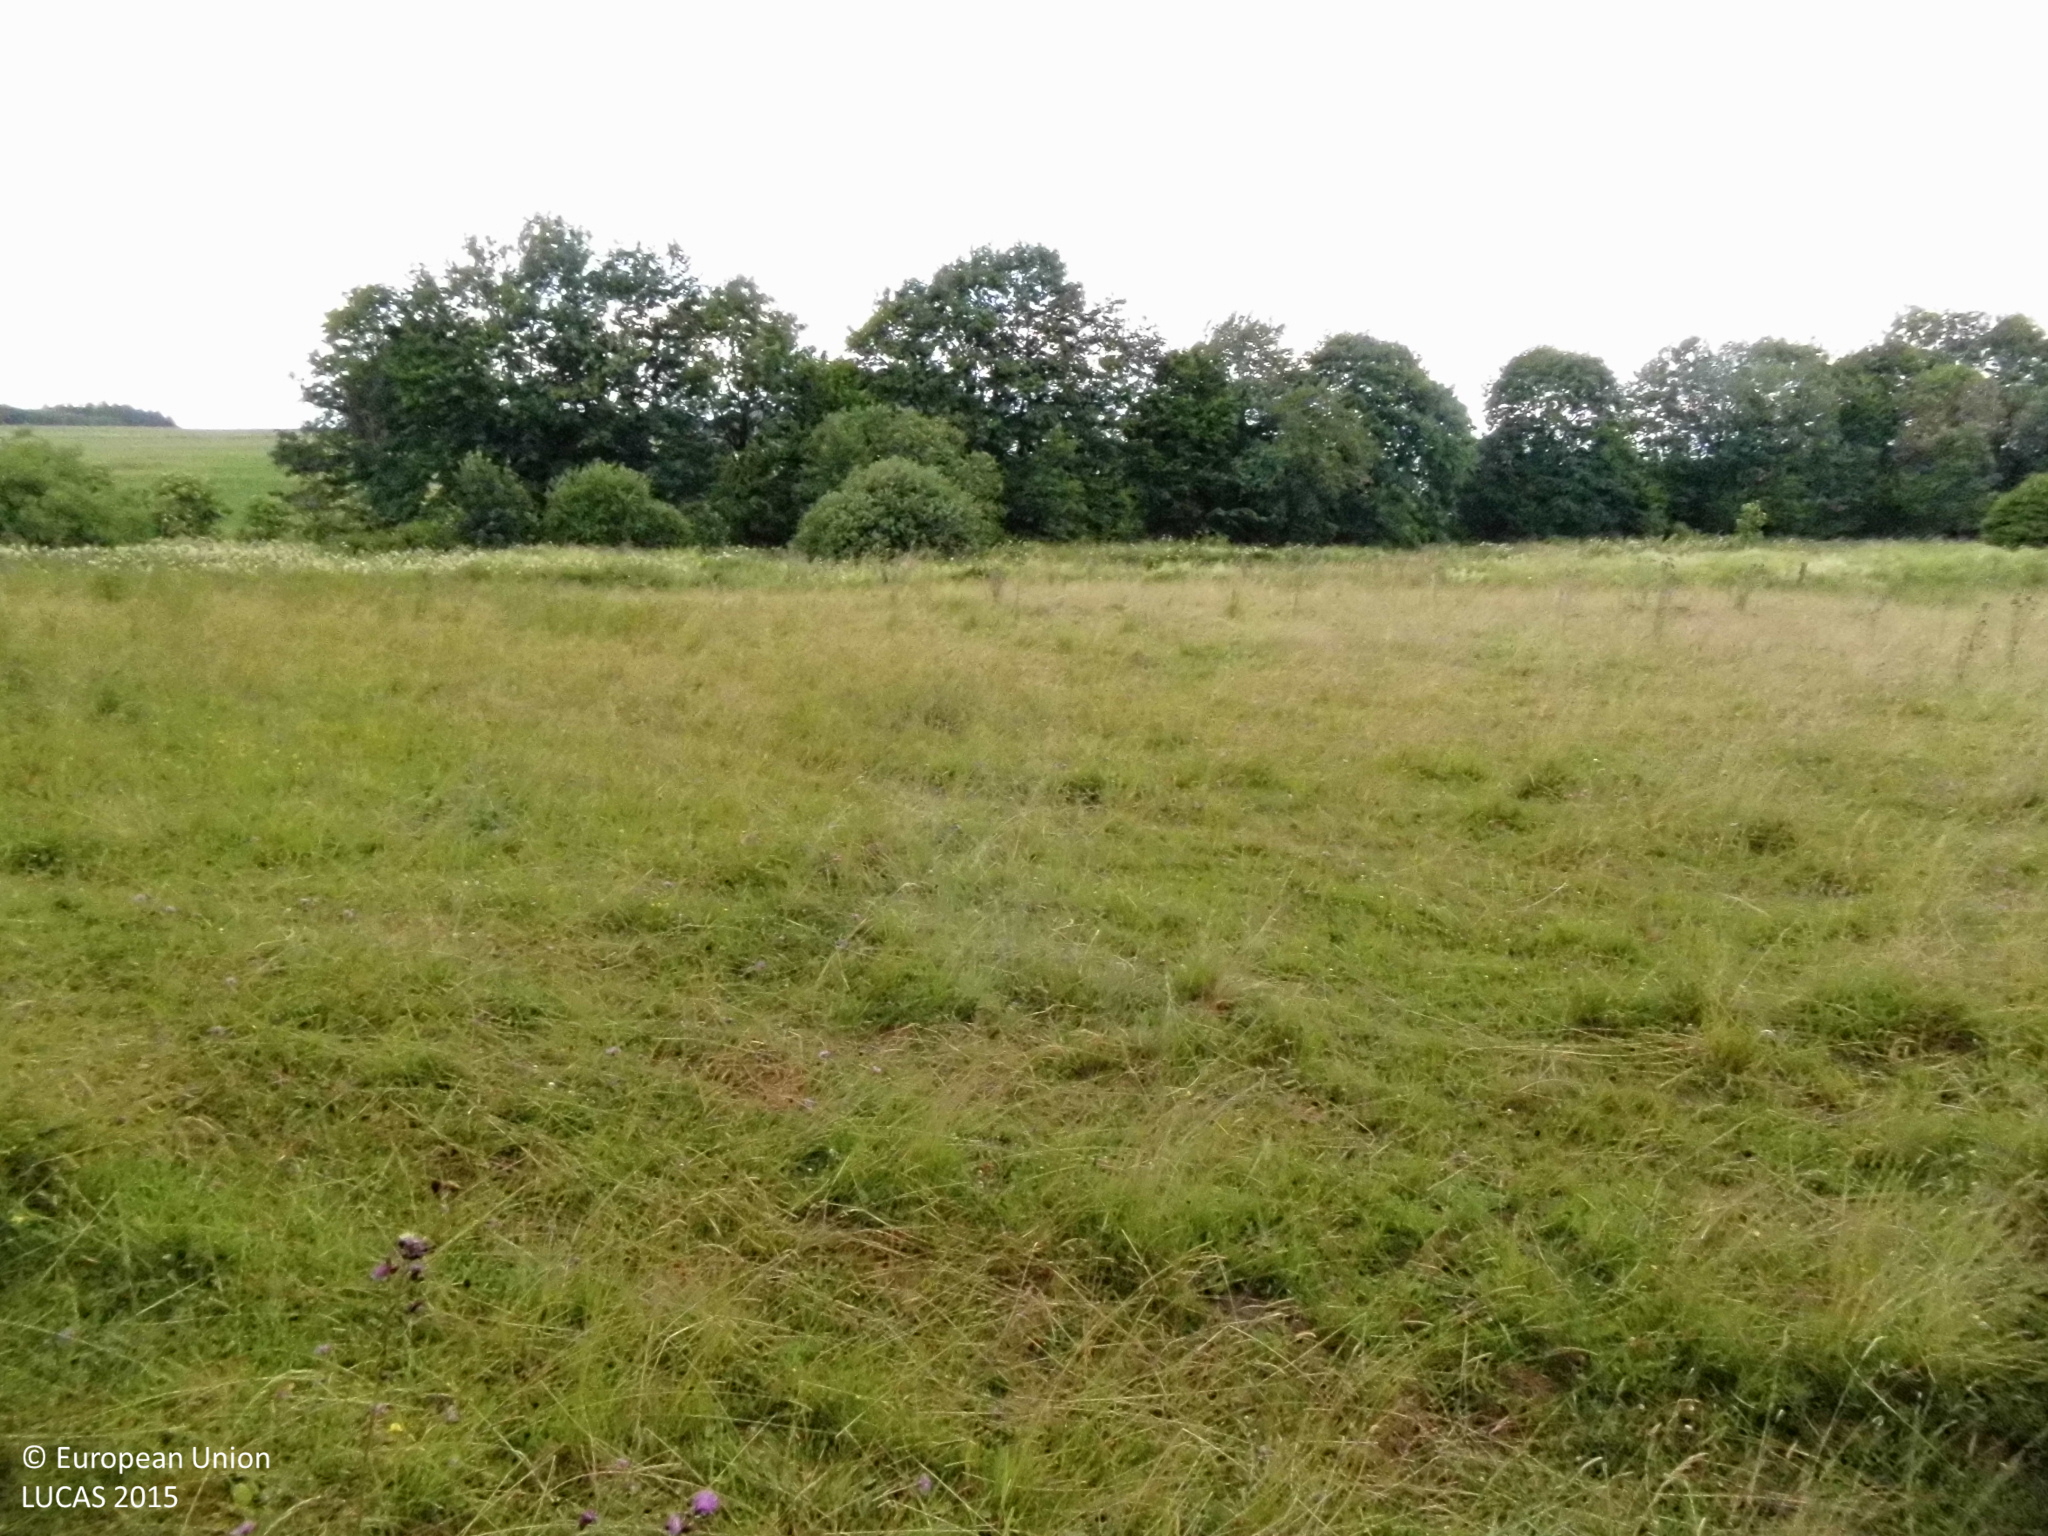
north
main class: Grassland
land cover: Spontaneously vegetated surfaces
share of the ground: 25 - 50 %
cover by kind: herbaceous plants 95 %, shrubs 5 %
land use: Agriculture (excluding fallow land and kitchen gardens)
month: July
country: DE
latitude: 50.6898
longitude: 8.0894
